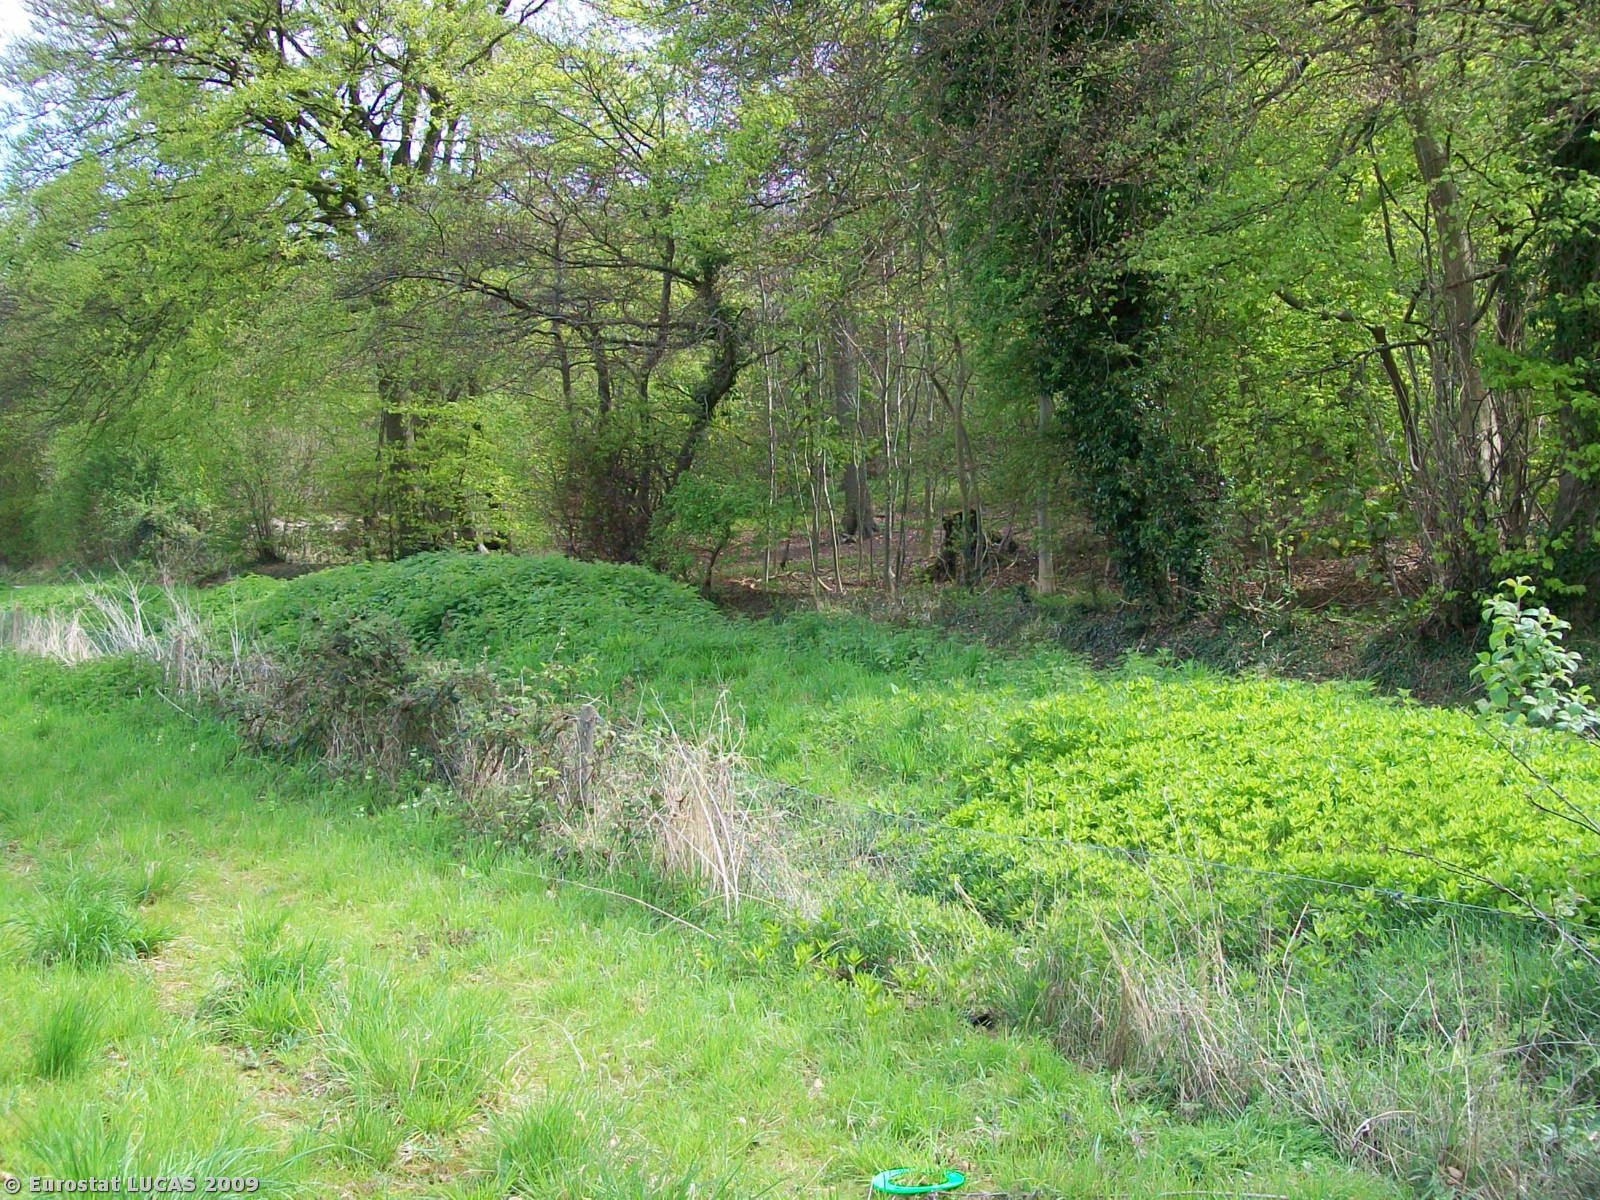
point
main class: Grassland
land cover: Grassland without tree/shrub cover
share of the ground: > 75 %
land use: Agriculture (excluding fallow land and kitchen gardens)
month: April
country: GB
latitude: 51.5400
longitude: -0.7833
